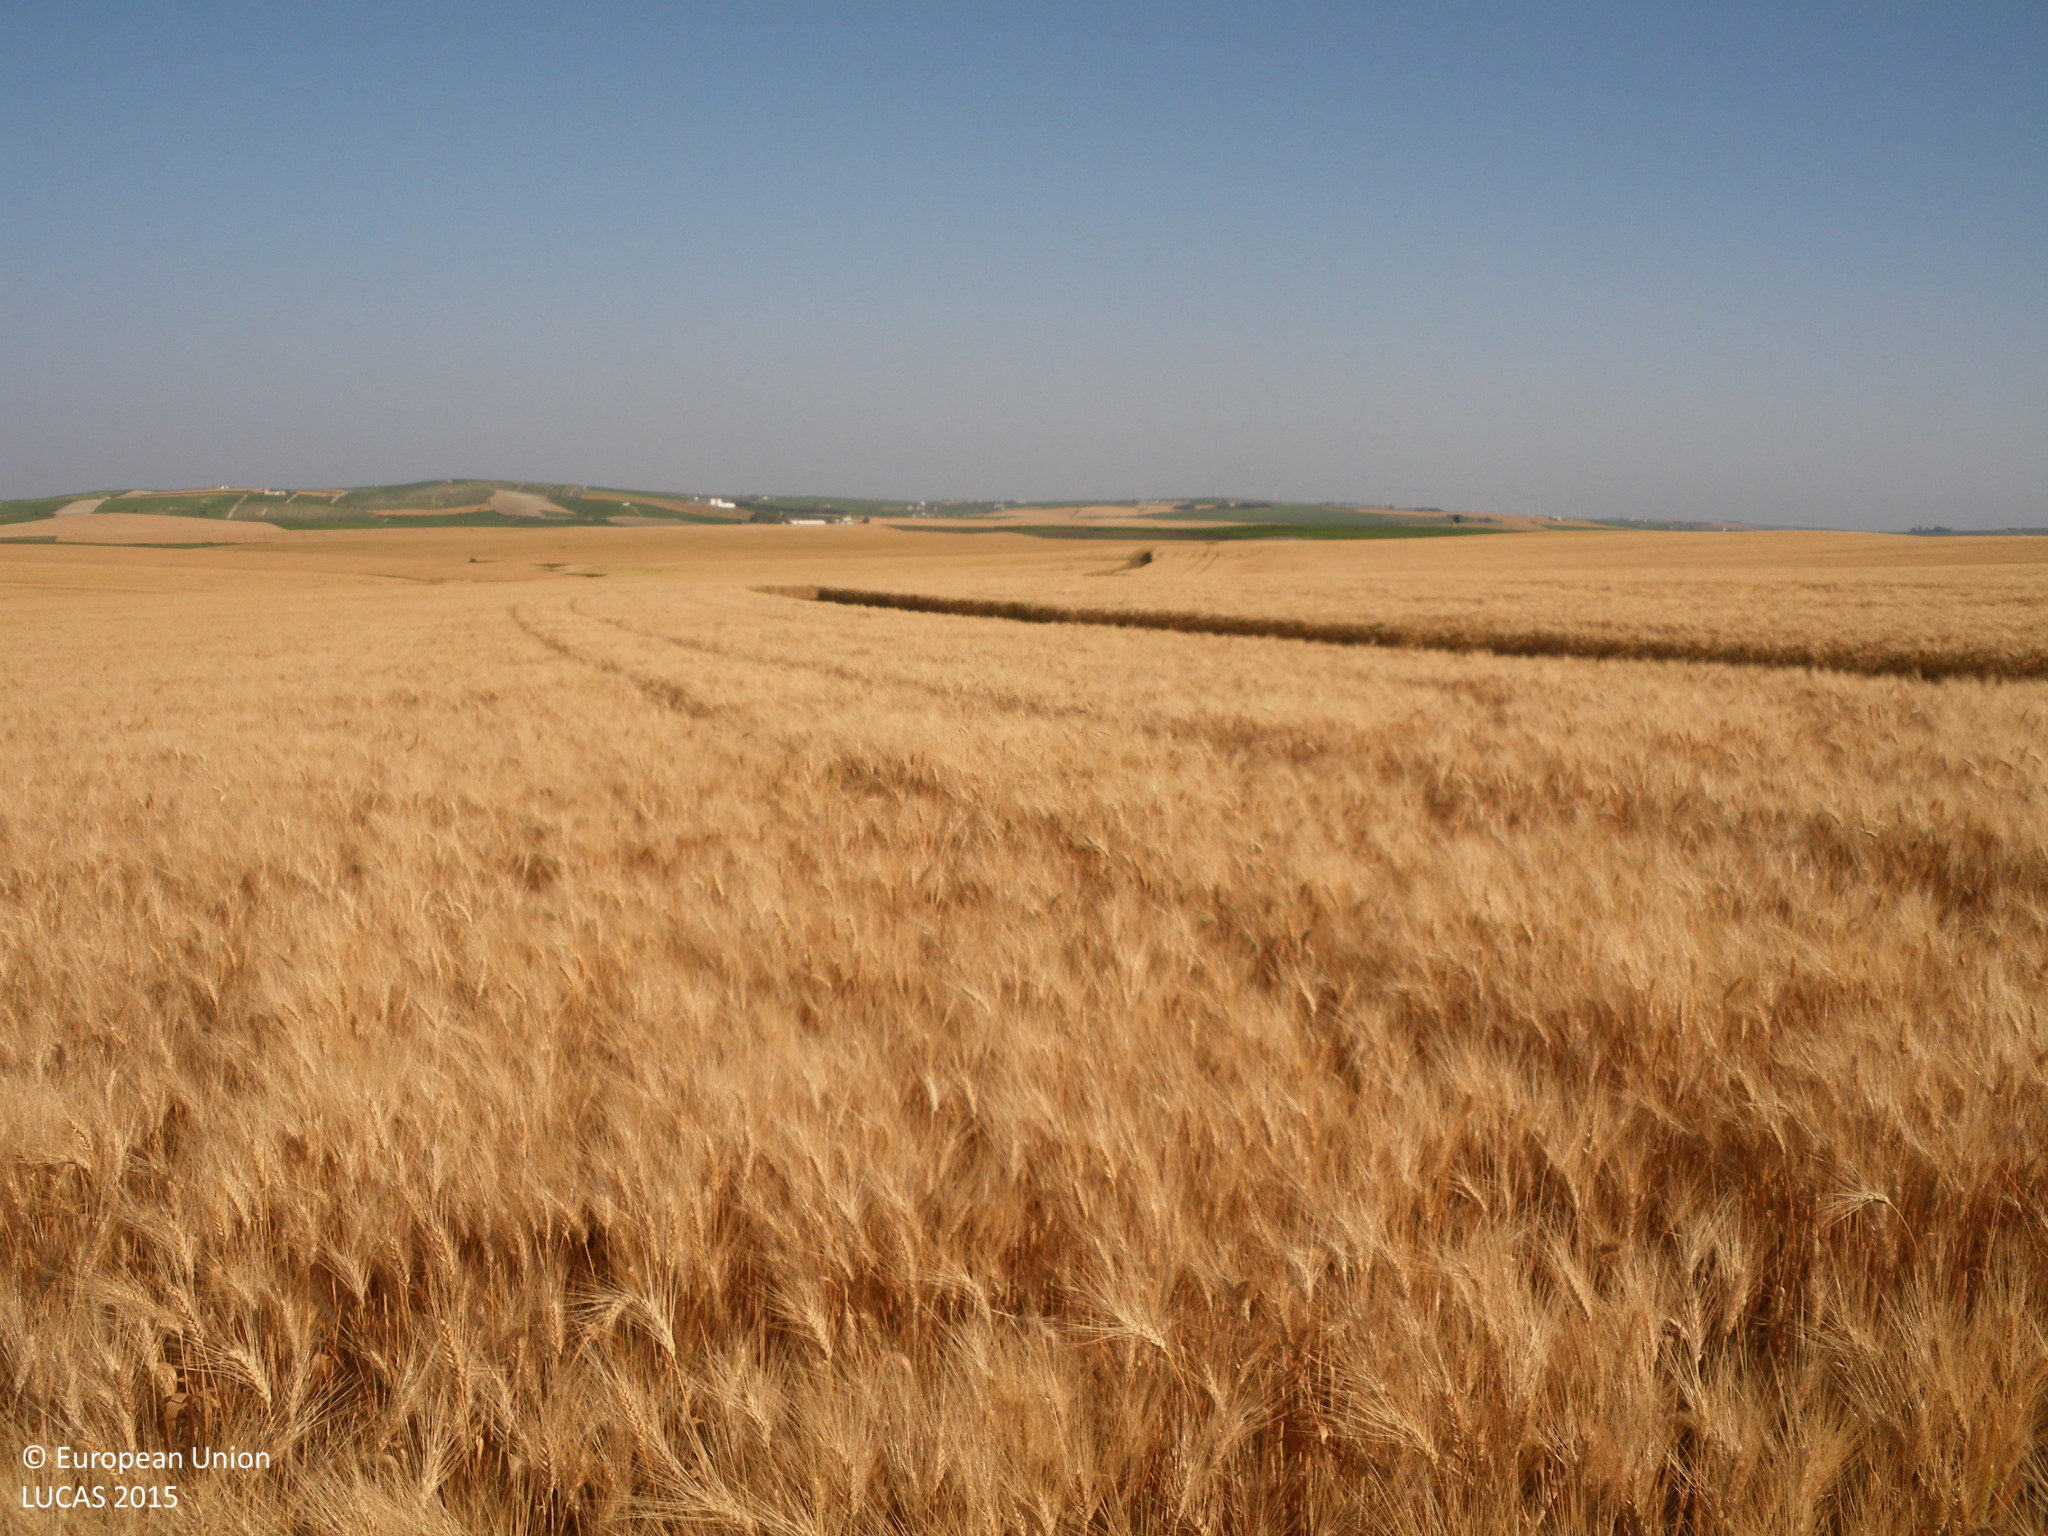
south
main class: Cropland
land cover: Durum wheat
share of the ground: > 75 %
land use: Agriculture (excluding fallow land and kitchen gardens)
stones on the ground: < 10 %
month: May
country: ES
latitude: 36.7683
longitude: -6.2263
